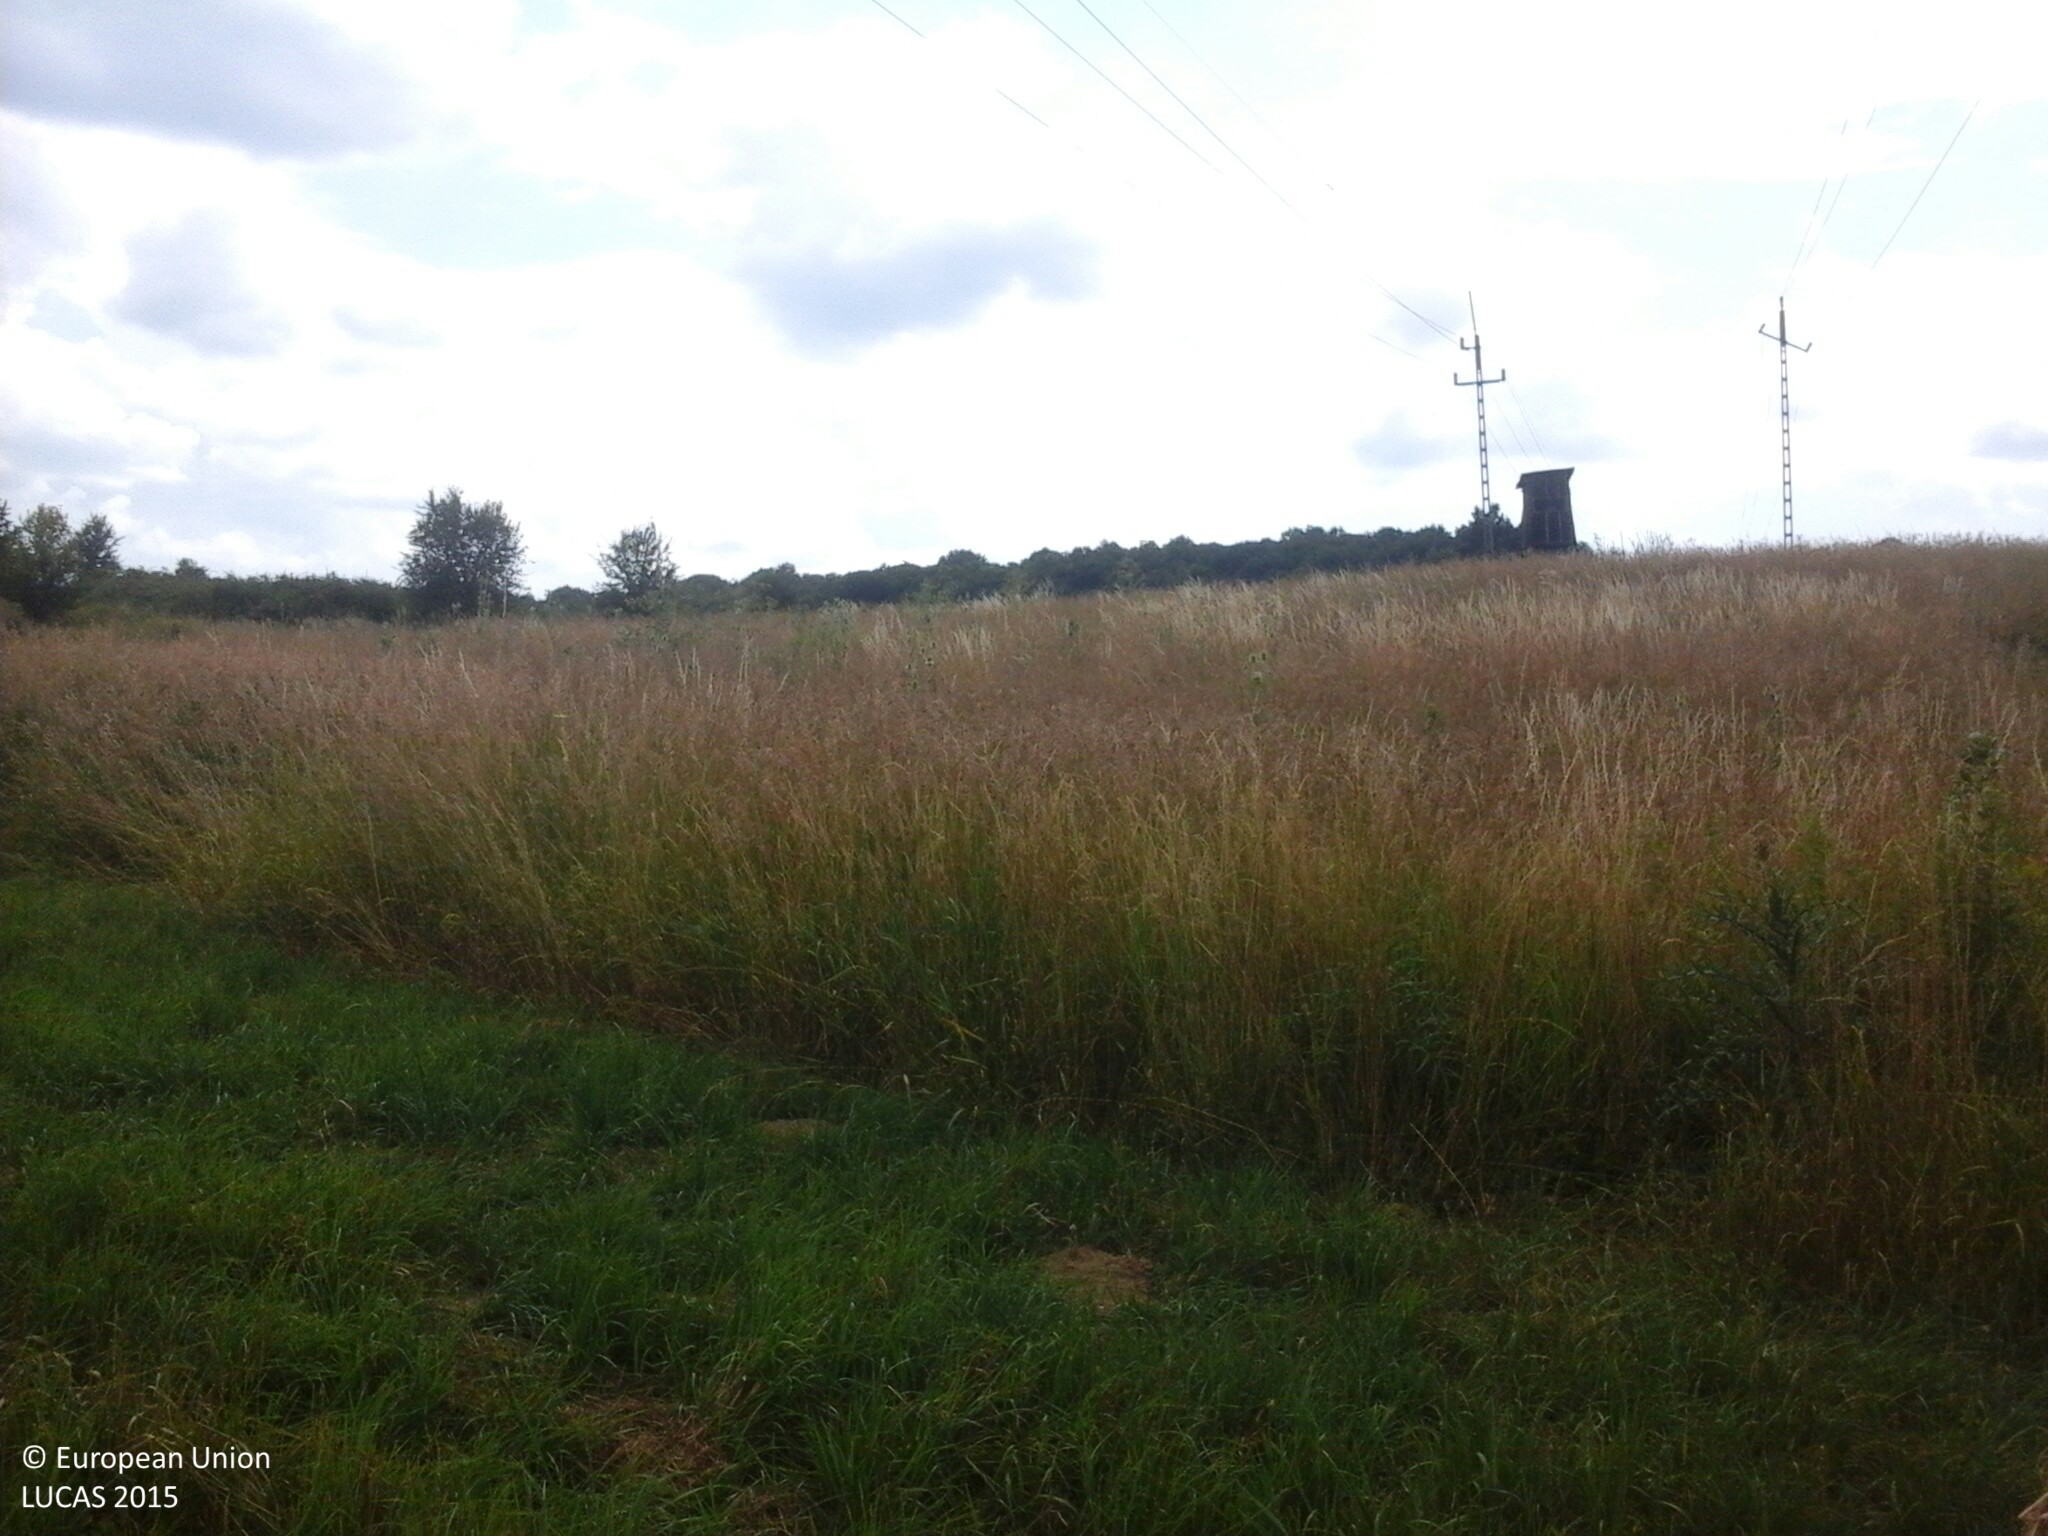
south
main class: Grassland
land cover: Spontaneously vegetated surfaces
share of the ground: > 75 %
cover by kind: herbaceous plants 100 %
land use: Semi-natural and natural areas not in use
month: July
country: HU
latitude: 47.3007
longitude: 17.9849
